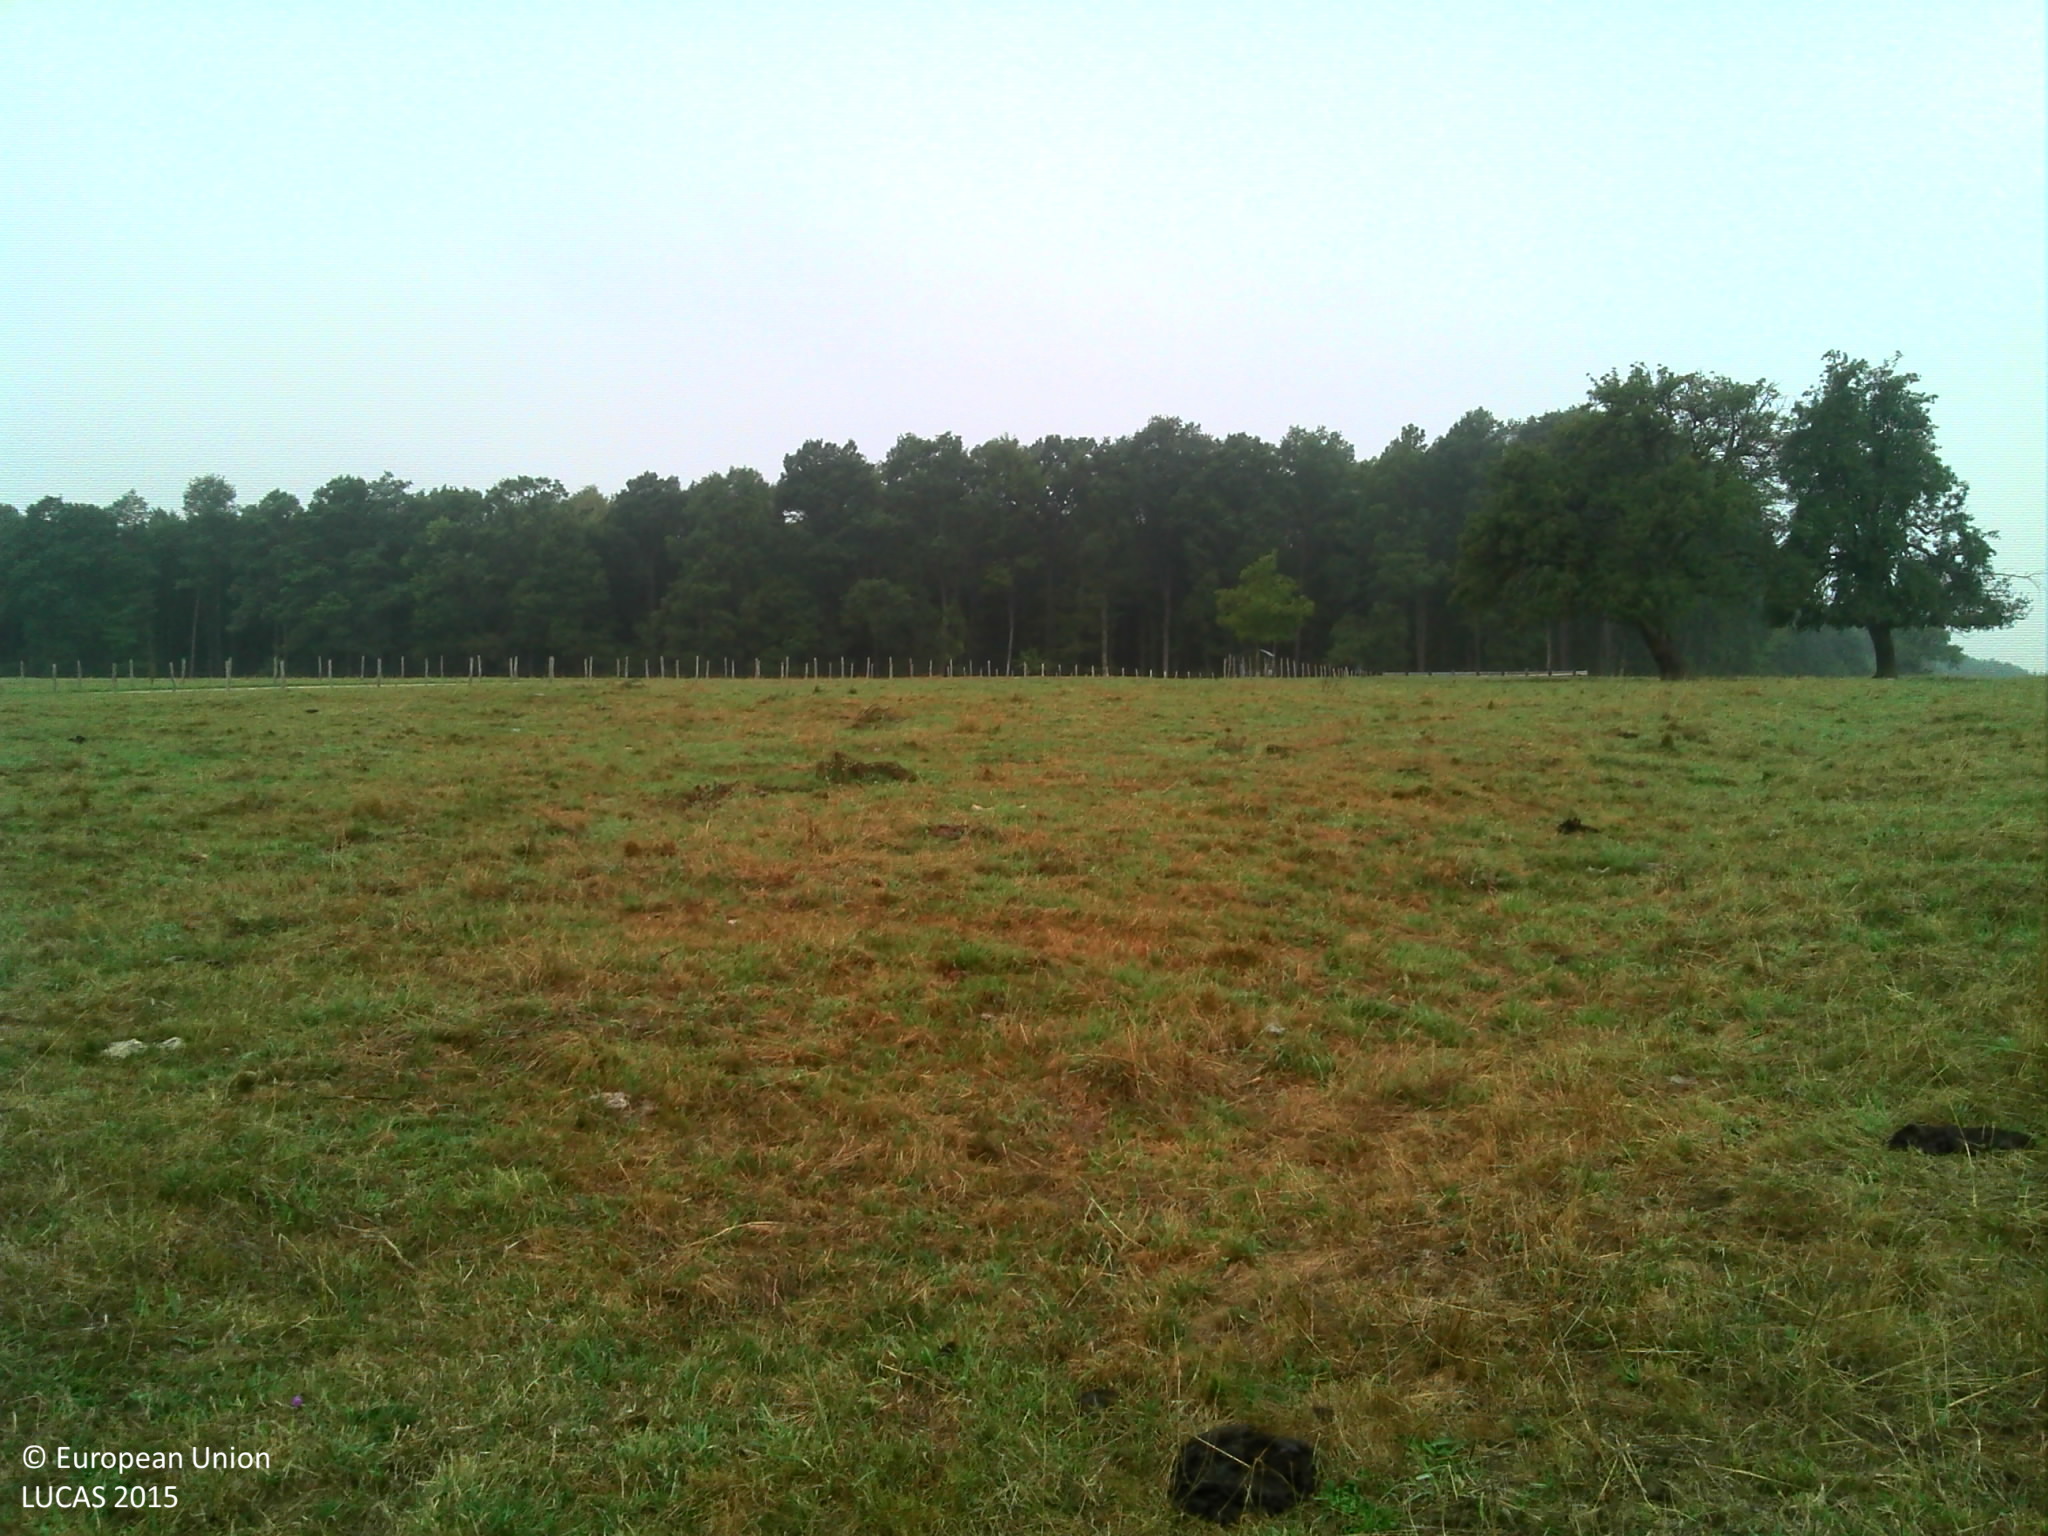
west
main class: Grassland
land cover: Grassland without tree/shrub cover
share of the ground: > 75 %
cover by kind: herbaceous plants 100 %
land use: Agriculture (excluding fallow land and kitchen gardens)
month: August
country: FR
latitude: 48.8377
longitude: 7.2621
